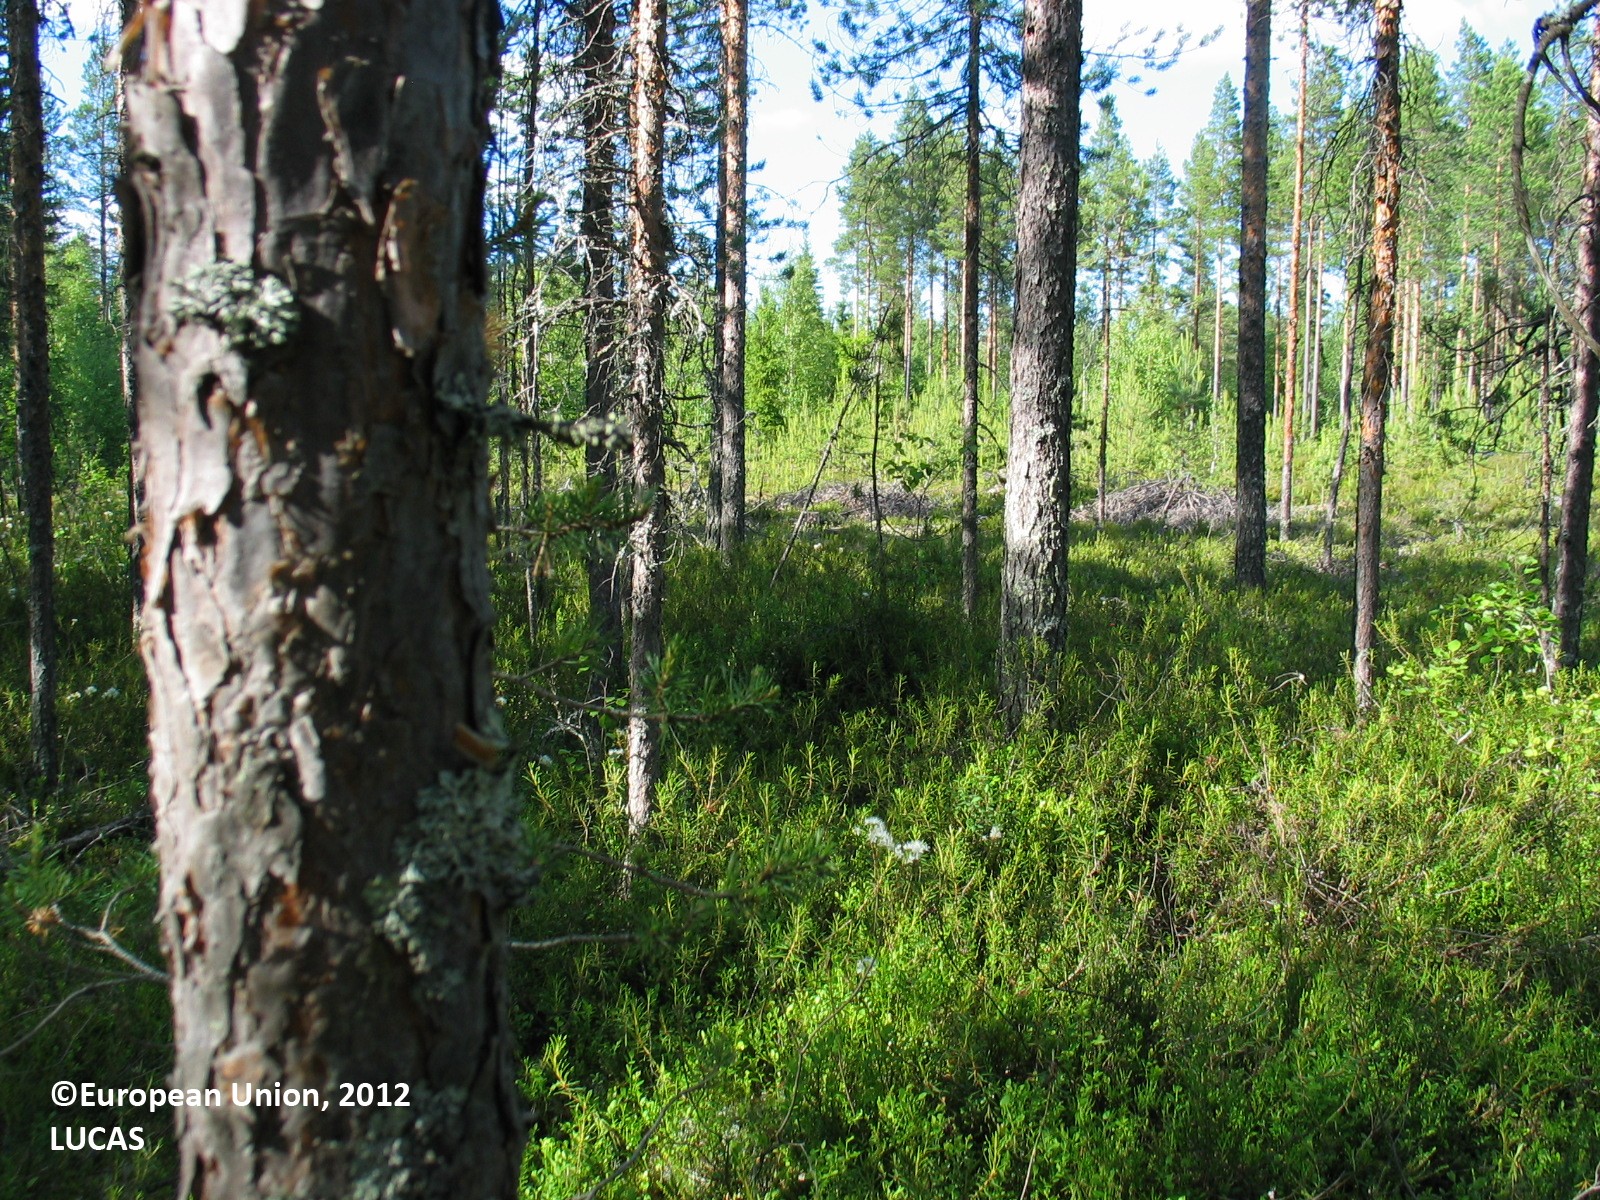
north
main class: Woodland
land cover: Pine dominated coniferous woodland
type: boreal forest
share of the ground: 50 - 75 %
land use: Forestry
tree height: > 5 m
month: July
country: FI
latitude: 64.6912
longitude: 26.7008
